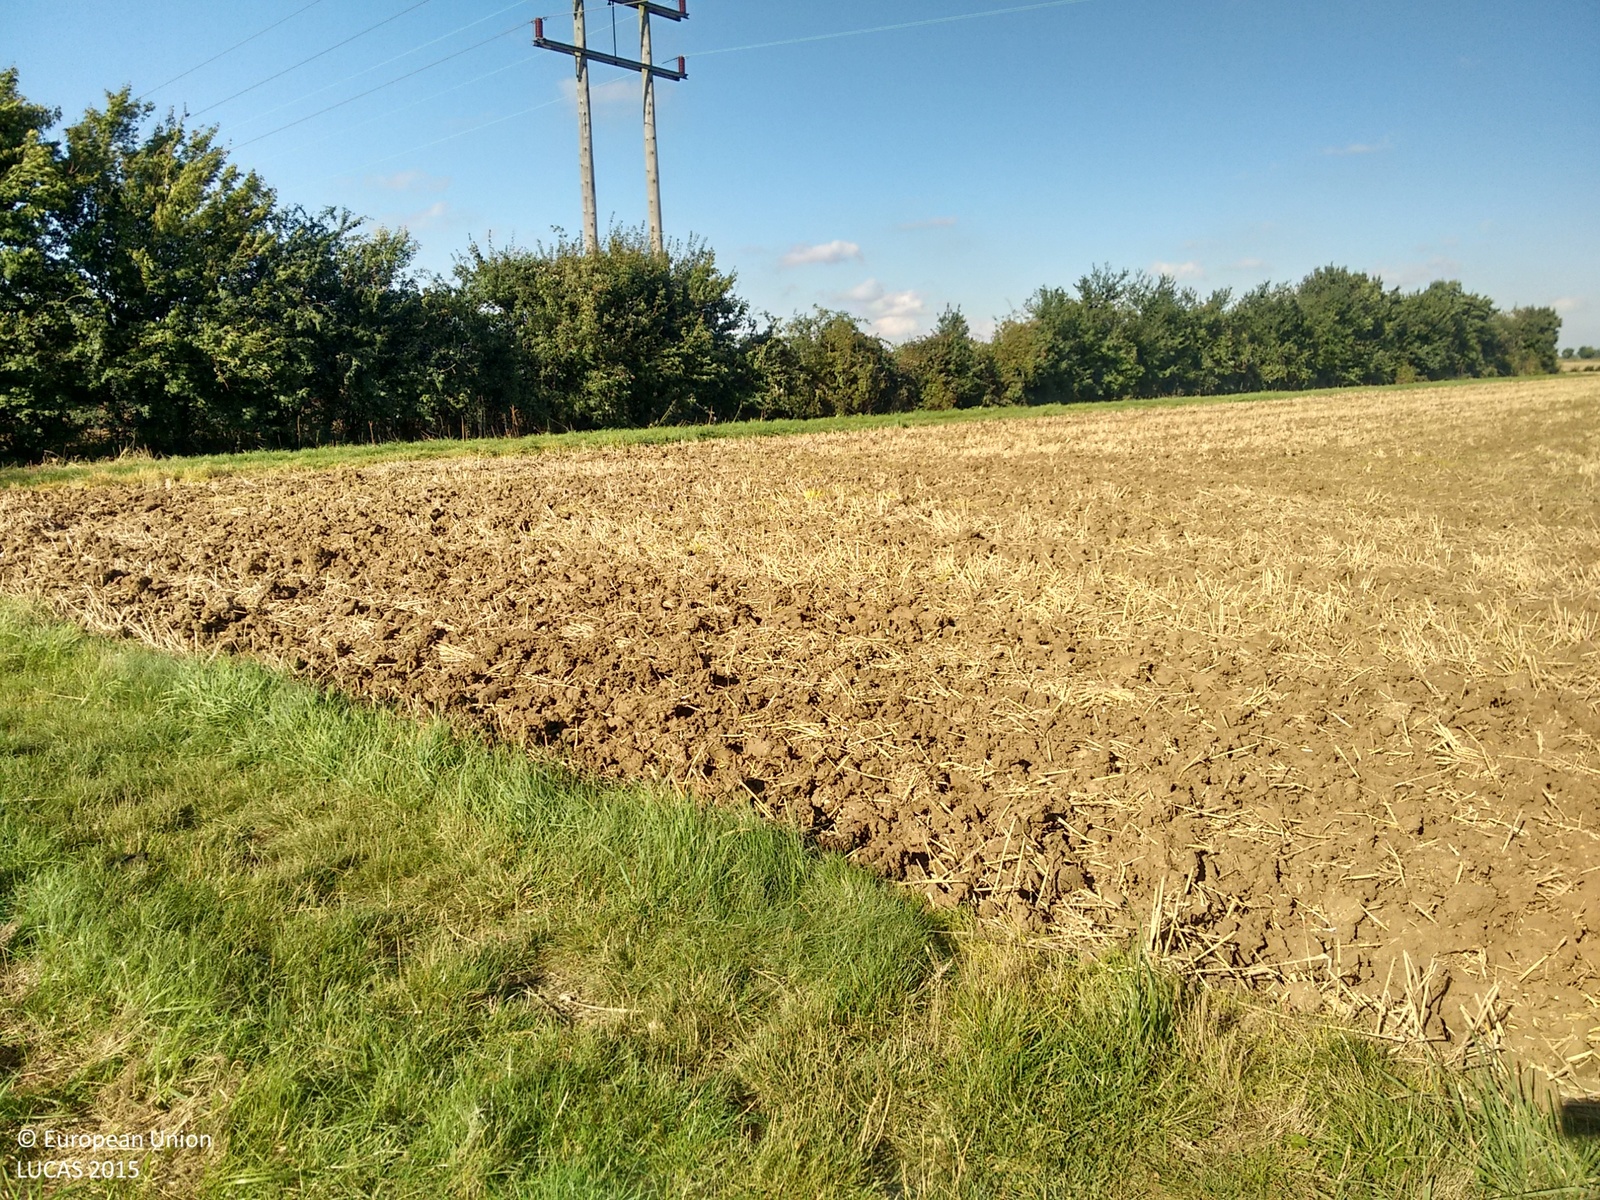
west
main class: Cropland
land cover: Common wheat
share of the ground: 10 - 25 %
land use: Agriculture (excluding fallow land and kitchen gardens)
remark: Harvested field
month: September
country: GB
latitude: 52.2089
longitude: 1.3897
